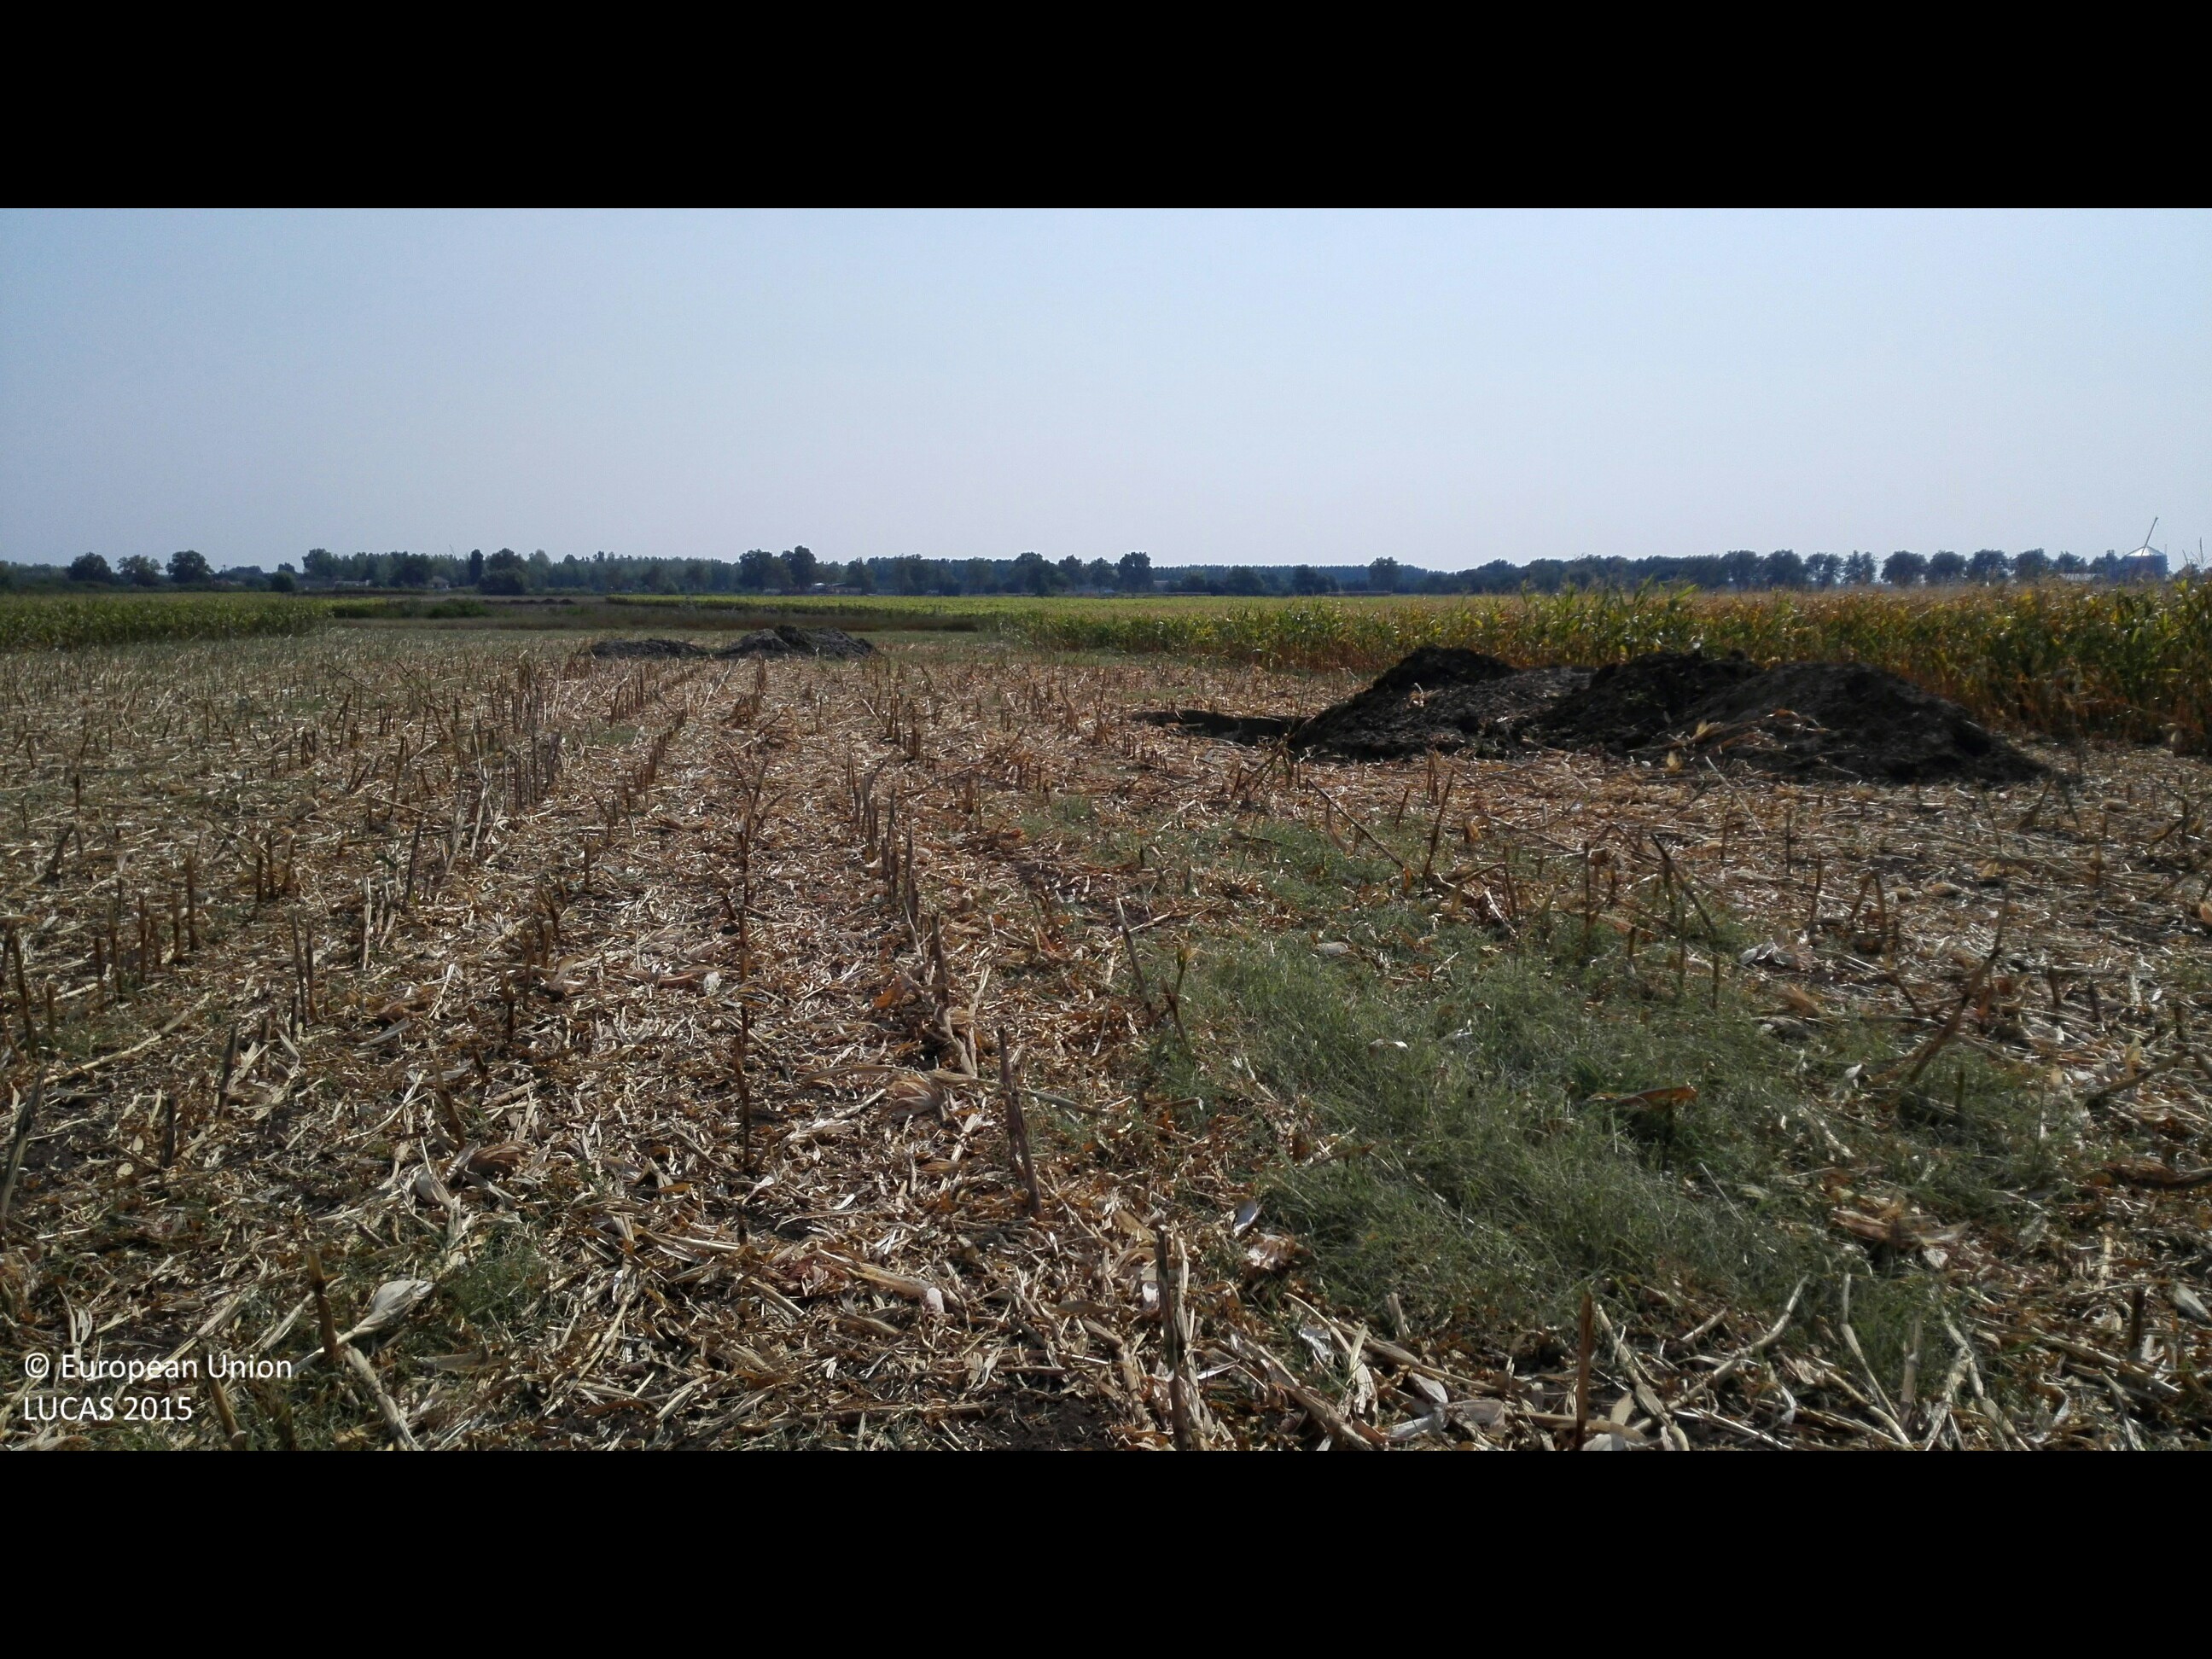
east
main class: Cropland
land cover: Maize
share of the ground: 10 - 25 %
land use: Agriculture (excluding fallow land and kitchen gardens)
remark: Harvested field
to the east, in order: Maize; Grass margins; Inland fresh running water; Grass margins; Tracks; Grass margins; Sunflower
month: August
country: HU
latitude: 47.4607
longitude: 21.6249
